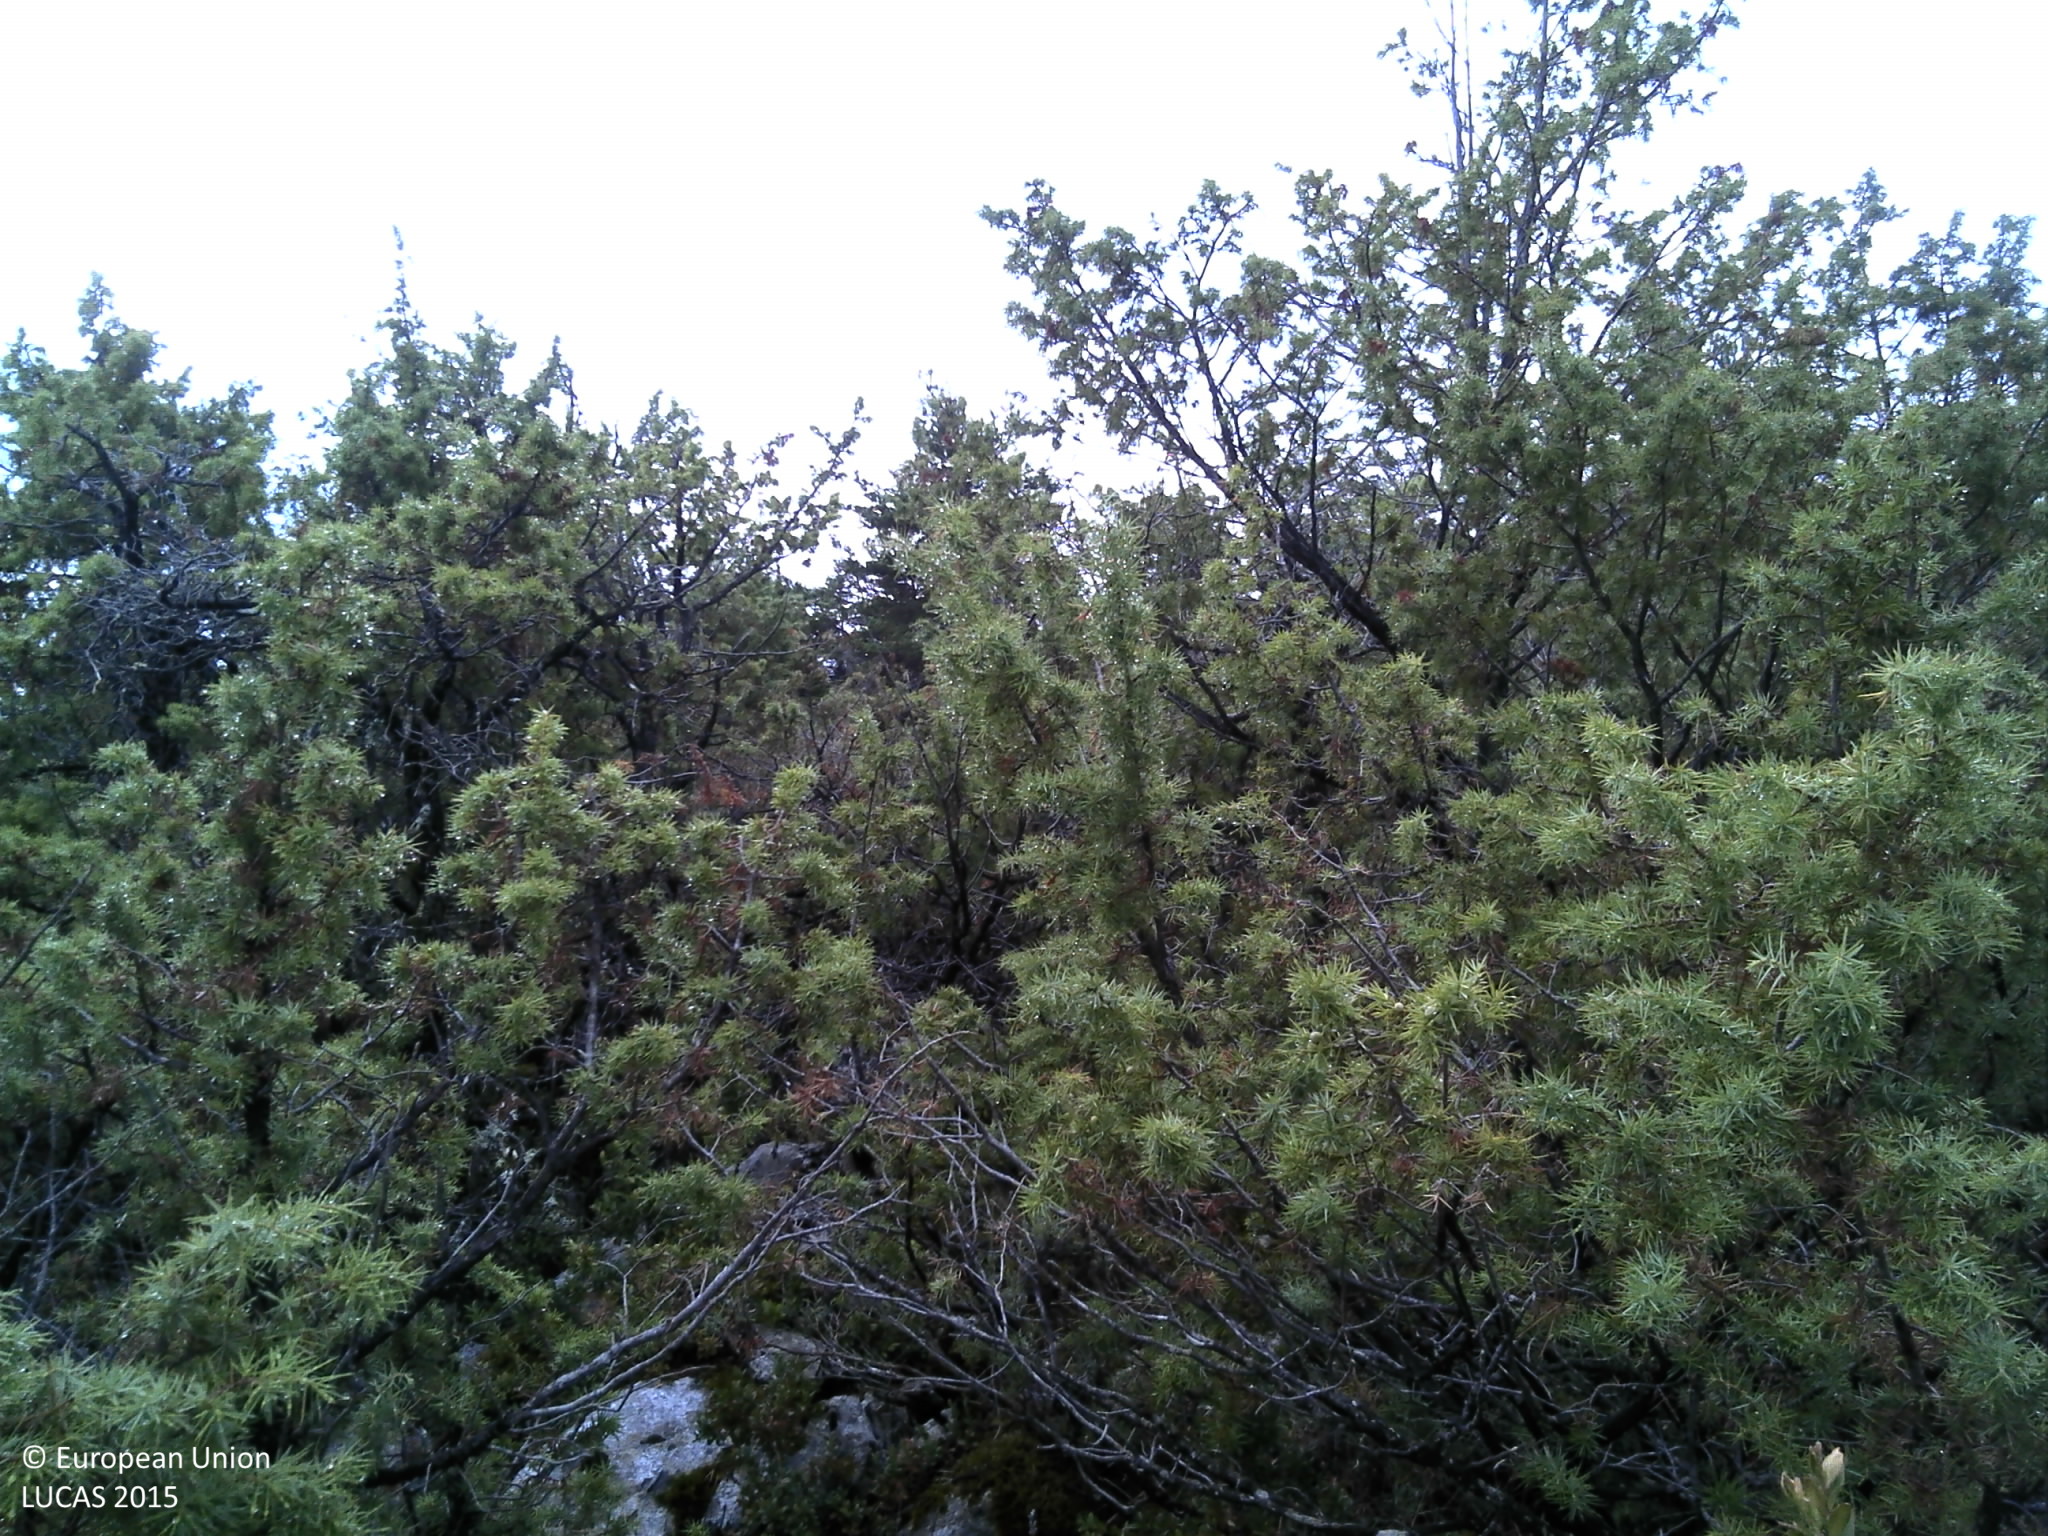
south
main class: Woodland
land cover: Pine dominated coniferous woodland
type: coniferous forest of the mediterranean region
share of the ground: > 75 %
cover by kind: coniferous forest trees 75 %, shrubs 15 %, lichens and mosses 5 %, consolidated bare surface 5 %
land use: Semi-natural and natural areas not in use
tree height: > 5 m
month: September
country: FR
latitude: 43.7471
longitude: 6.4192
